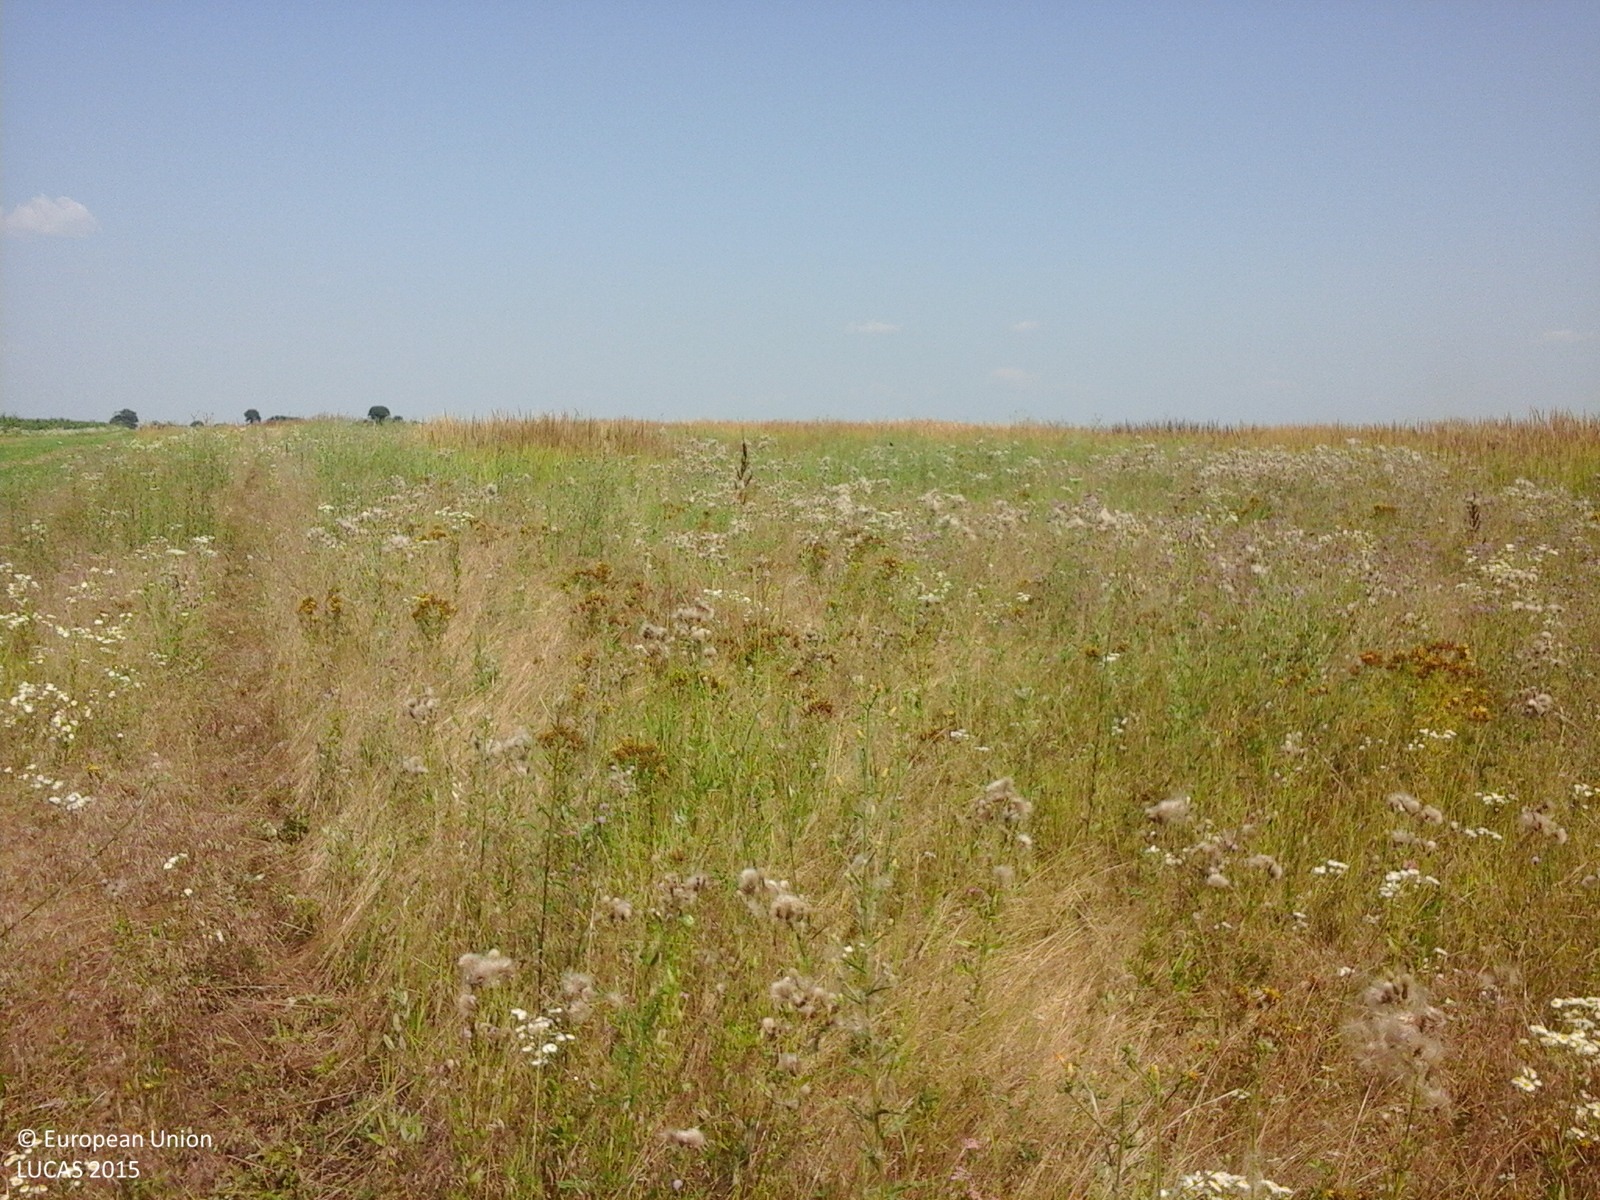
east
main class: Grassland
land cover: Spontaneously vegetated surfaces
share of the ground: > 75 %
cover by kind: herbaceous plants 100 %
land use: Agriculture (excluding fallow land and kitchen gardens)
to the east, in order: Spontaneously vegetated surfaces; Sunflower
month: July
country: RO
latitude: 44.6457
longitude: 24.4835
